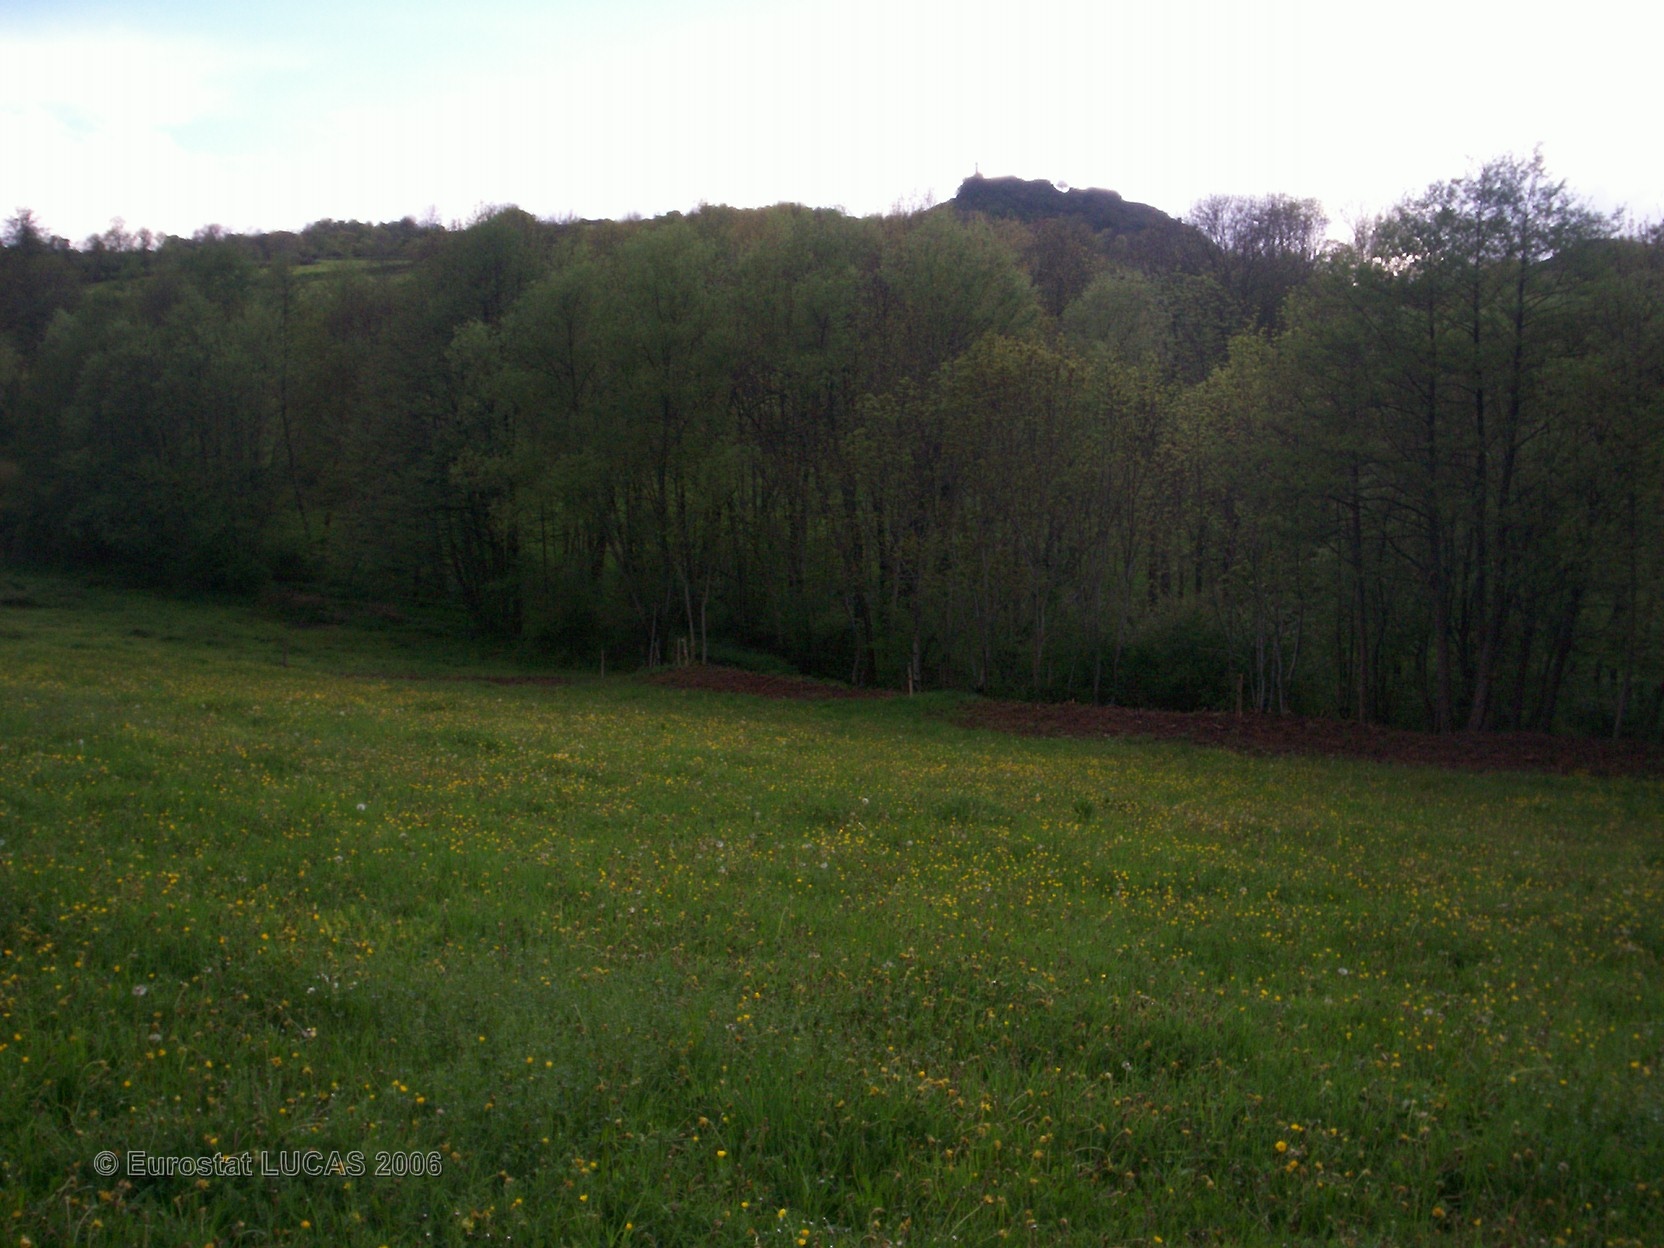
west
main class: Grassland
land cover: Grassland without tree/shrub cover
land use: Agriculture (excluding fallow land and kitchen gardens)
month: May
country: FR
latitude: 45.5299
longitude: 3.0733
